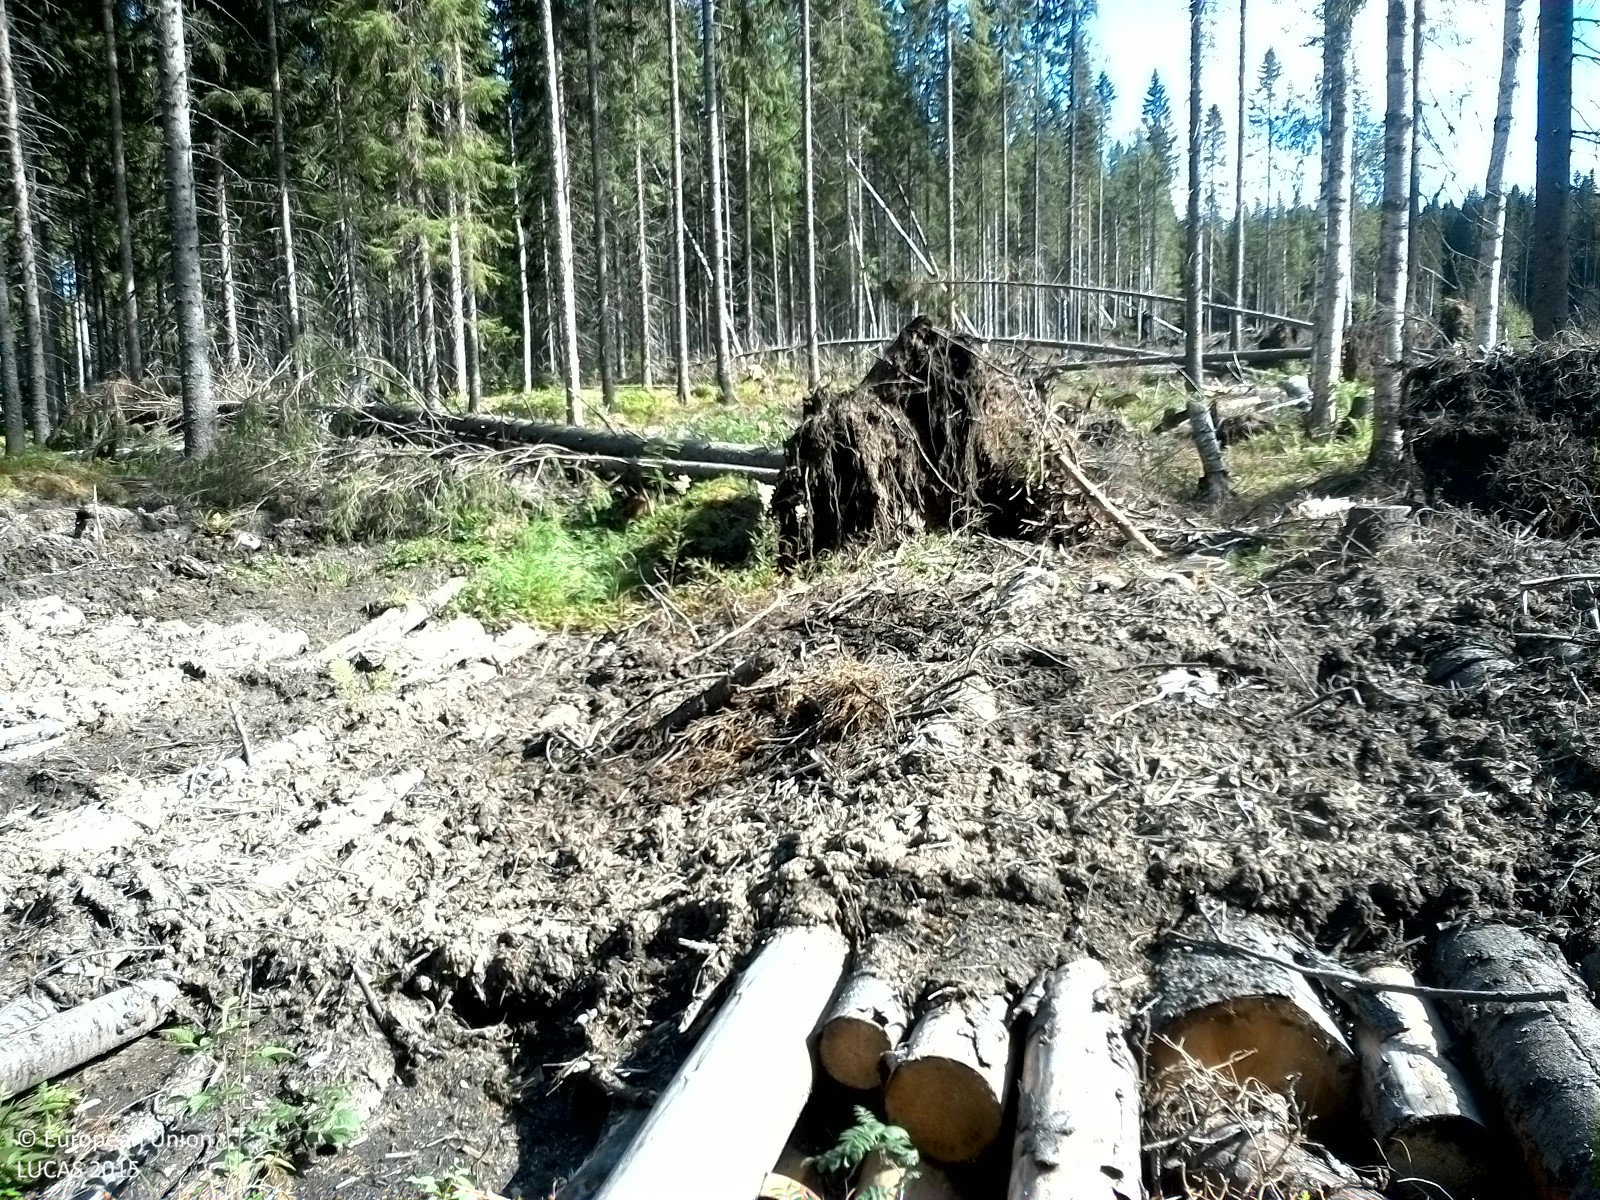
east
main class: Woodland
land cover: Spruce dominated coniferous woodland
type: boreal forest
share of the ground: 10 - 25 %
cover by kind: herbaceous plants 30 %, unconsolidated bare surface 25 %, coniferous forest trees 15 %, shrubs 15 %, lichens and mosses 15 %
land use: Forestry
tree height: > 5 m
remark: Clear cut
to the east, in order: Spruce dominated coniferous woodland; Tracks; Spruce dominated coniferous woodland; Tracks; Spruce dominated coniferous woodland; Tracks; Spruce dominated coniferous woodland; Tracks; Spruce dominated coniferous woodland; Spruce dominated mixed woodland
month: August
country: SE
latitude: 62.5806
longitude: 16.4996
